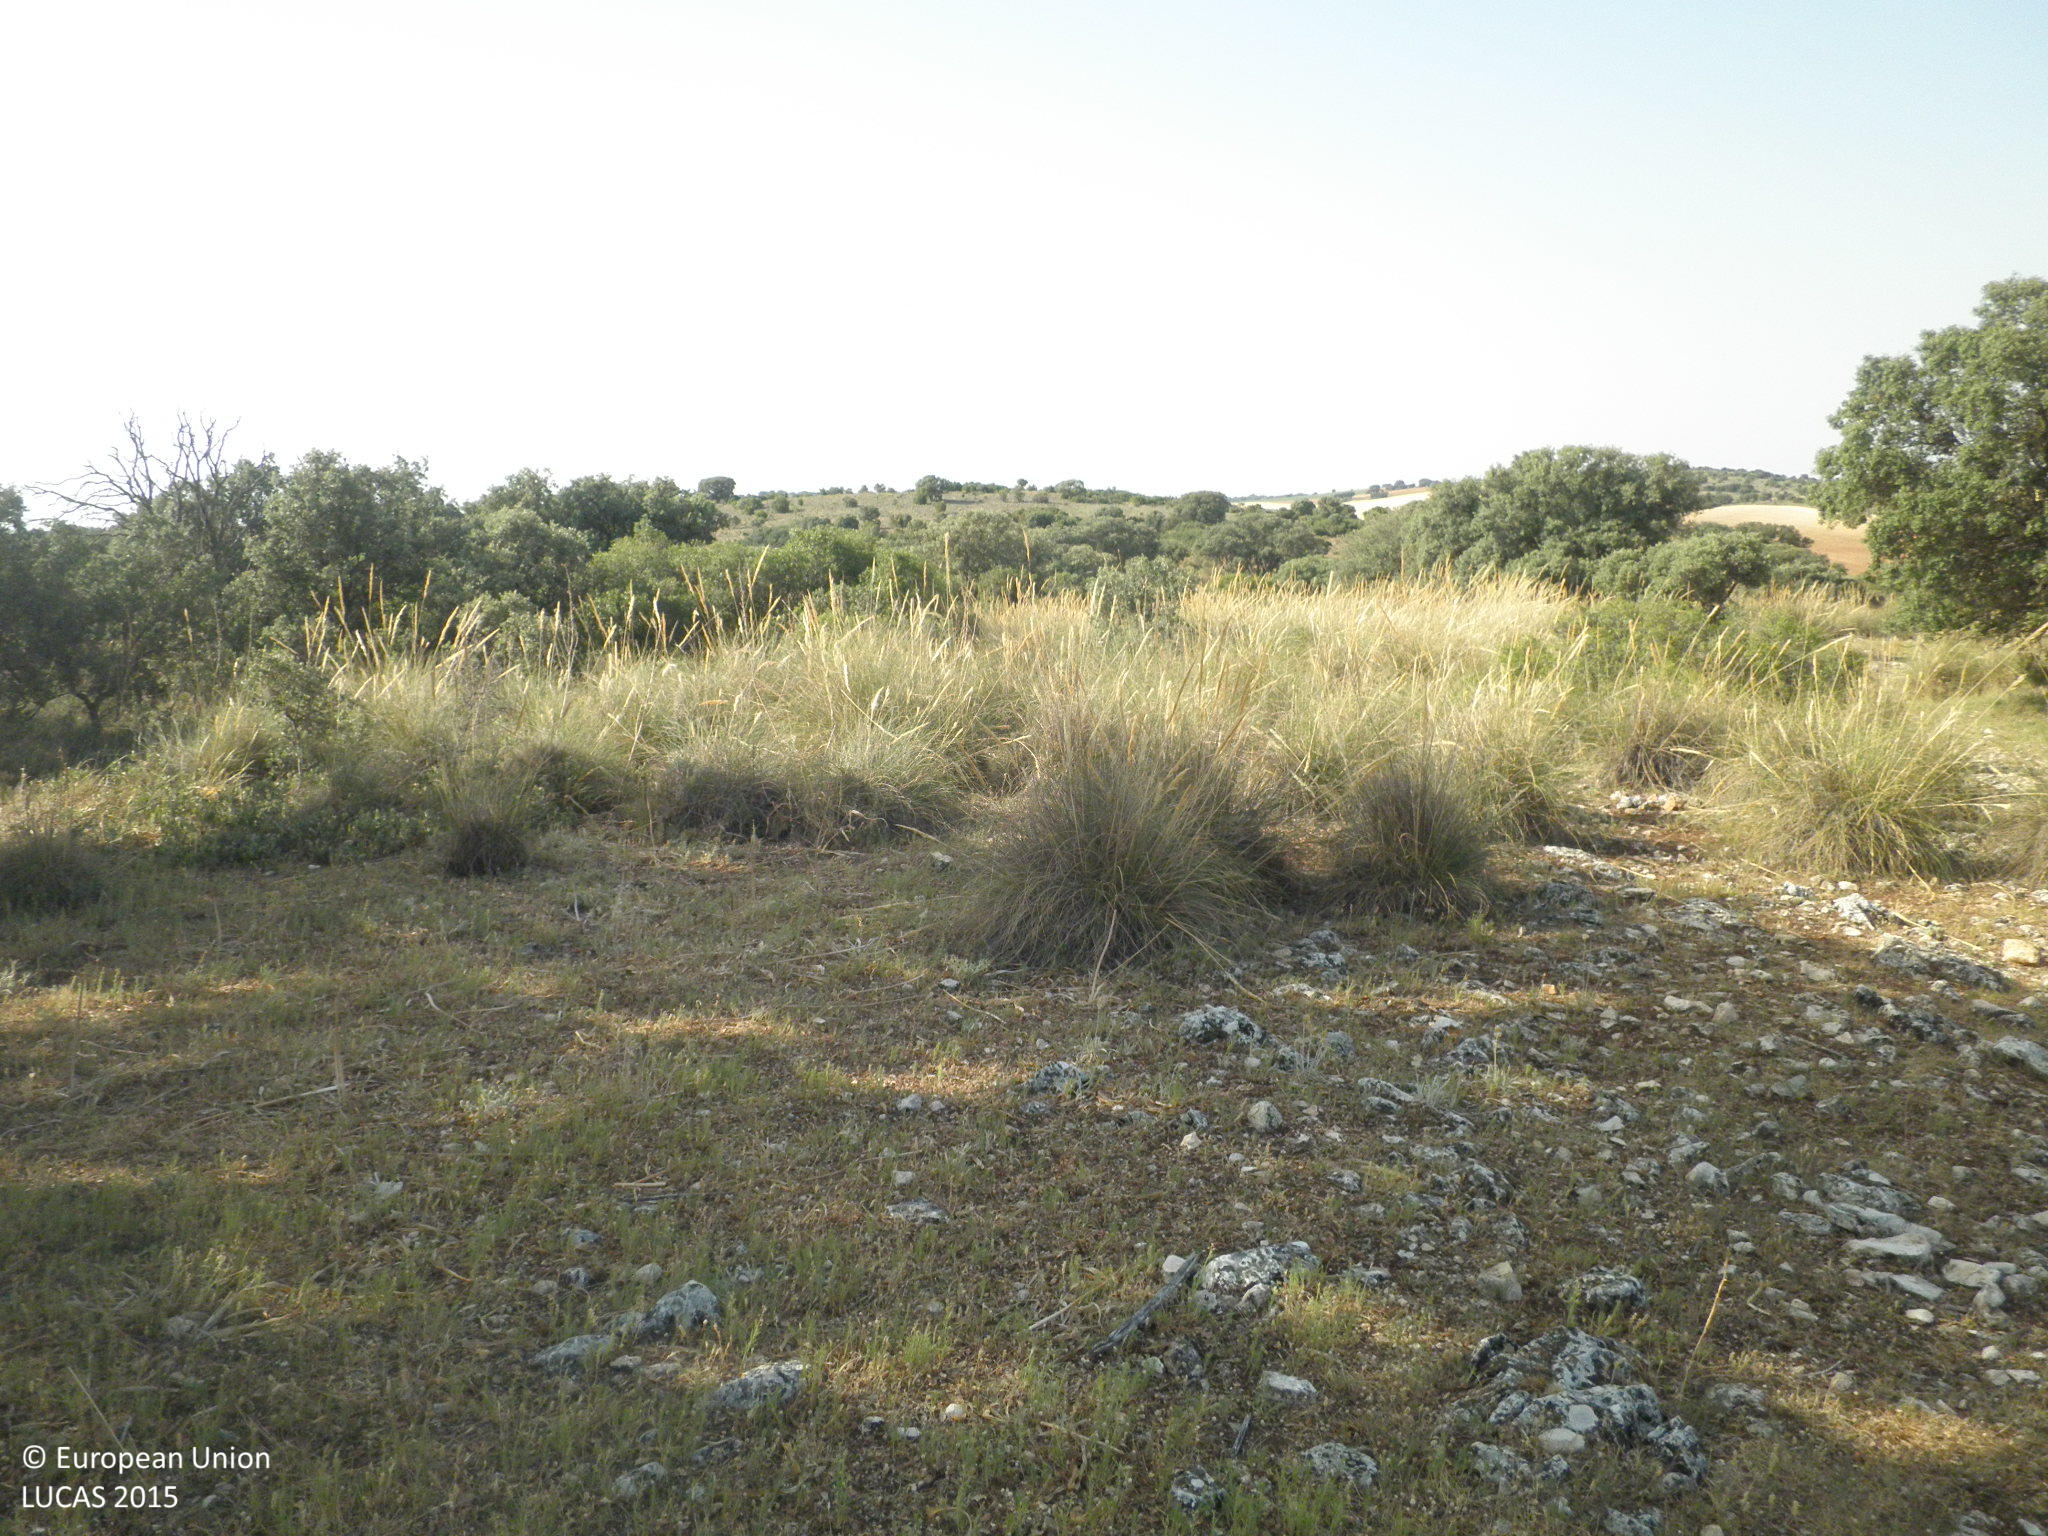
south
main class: Woodland
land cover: Broadleaved woodland
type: broadleaved evergreen forest
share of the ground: 10 - 25 %
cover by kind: herbaceous plants 60 %, consolidated bare surface 20 %, broadleaved forest trees 10 %, shrubs 10 %
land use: Semi-natural and natural areas not in use
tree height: > 5 m
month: July
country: ES
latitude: 39.6153
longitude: -2.6063
